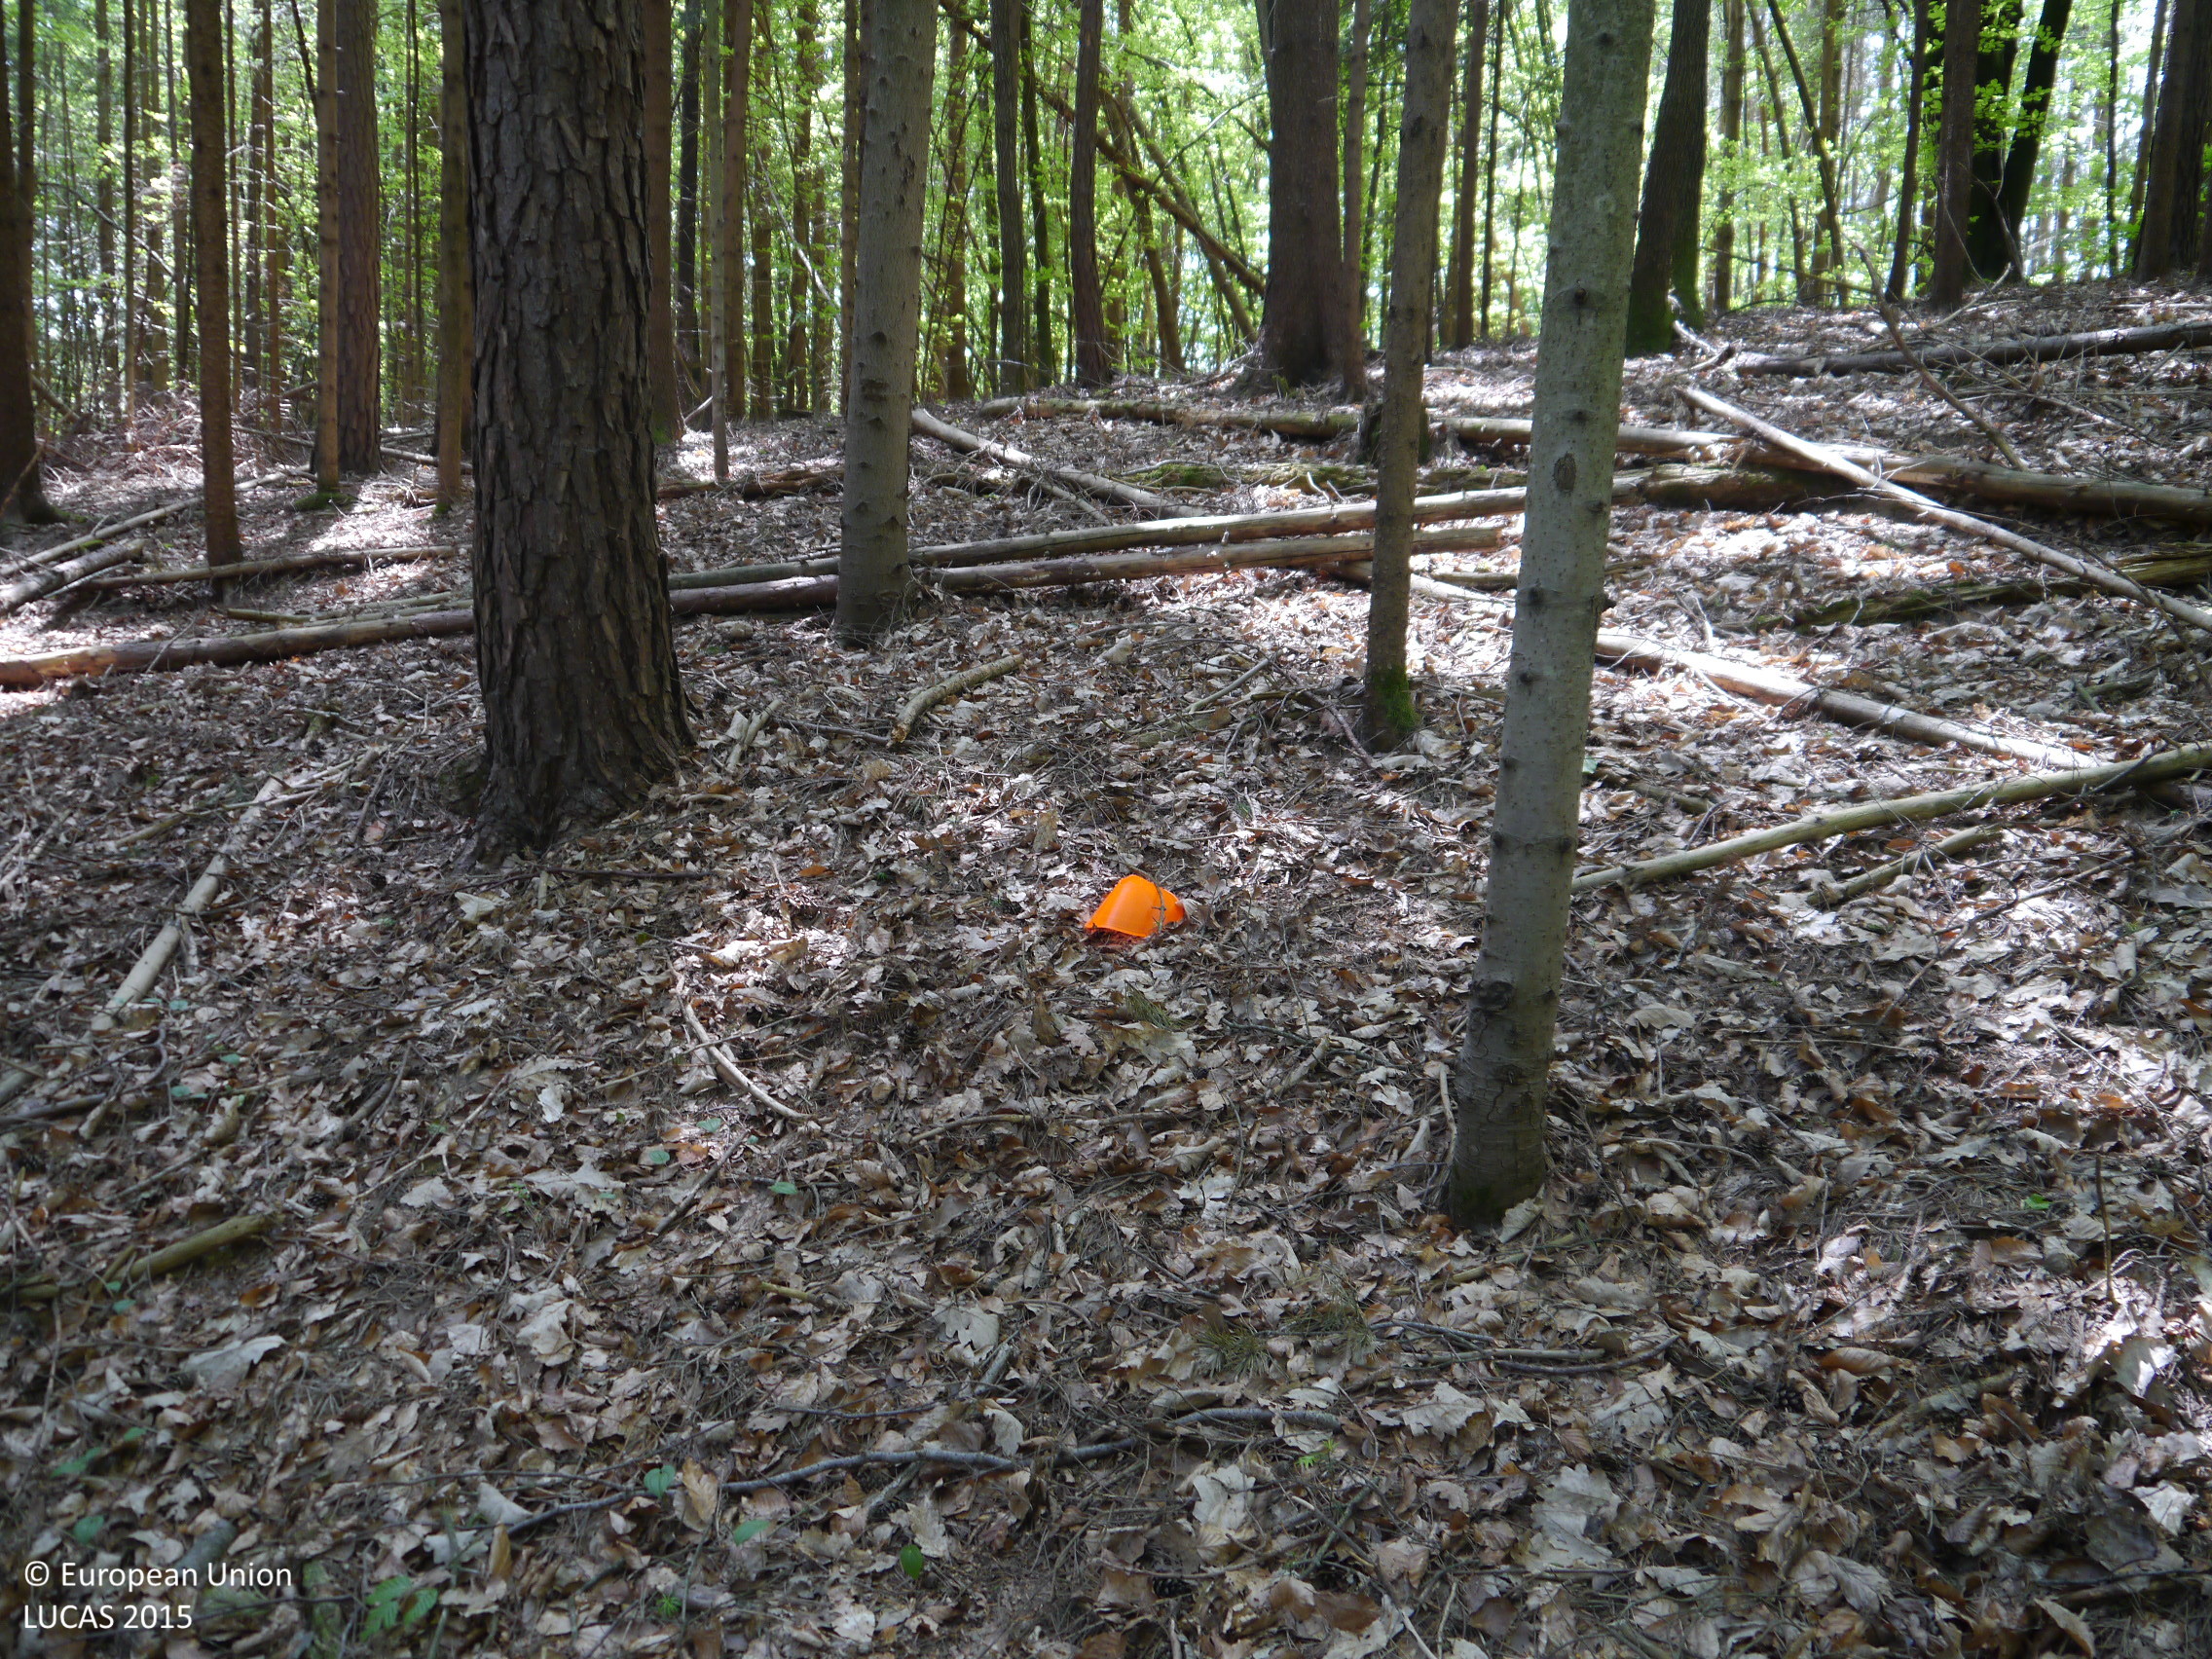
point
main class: Woodland
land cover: Spruce dominated mixed woodland
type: hemiboreal forest and nemoral coniferous forest and mixed broadleaved-coniferous forest
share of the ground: > 75 %
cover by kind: coniferous forest trees 70 %, broadleaved forest trees 30 %
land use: Forestry
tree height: > 5 m
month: May
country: AT
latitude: 47.1049
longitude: 15.2836
